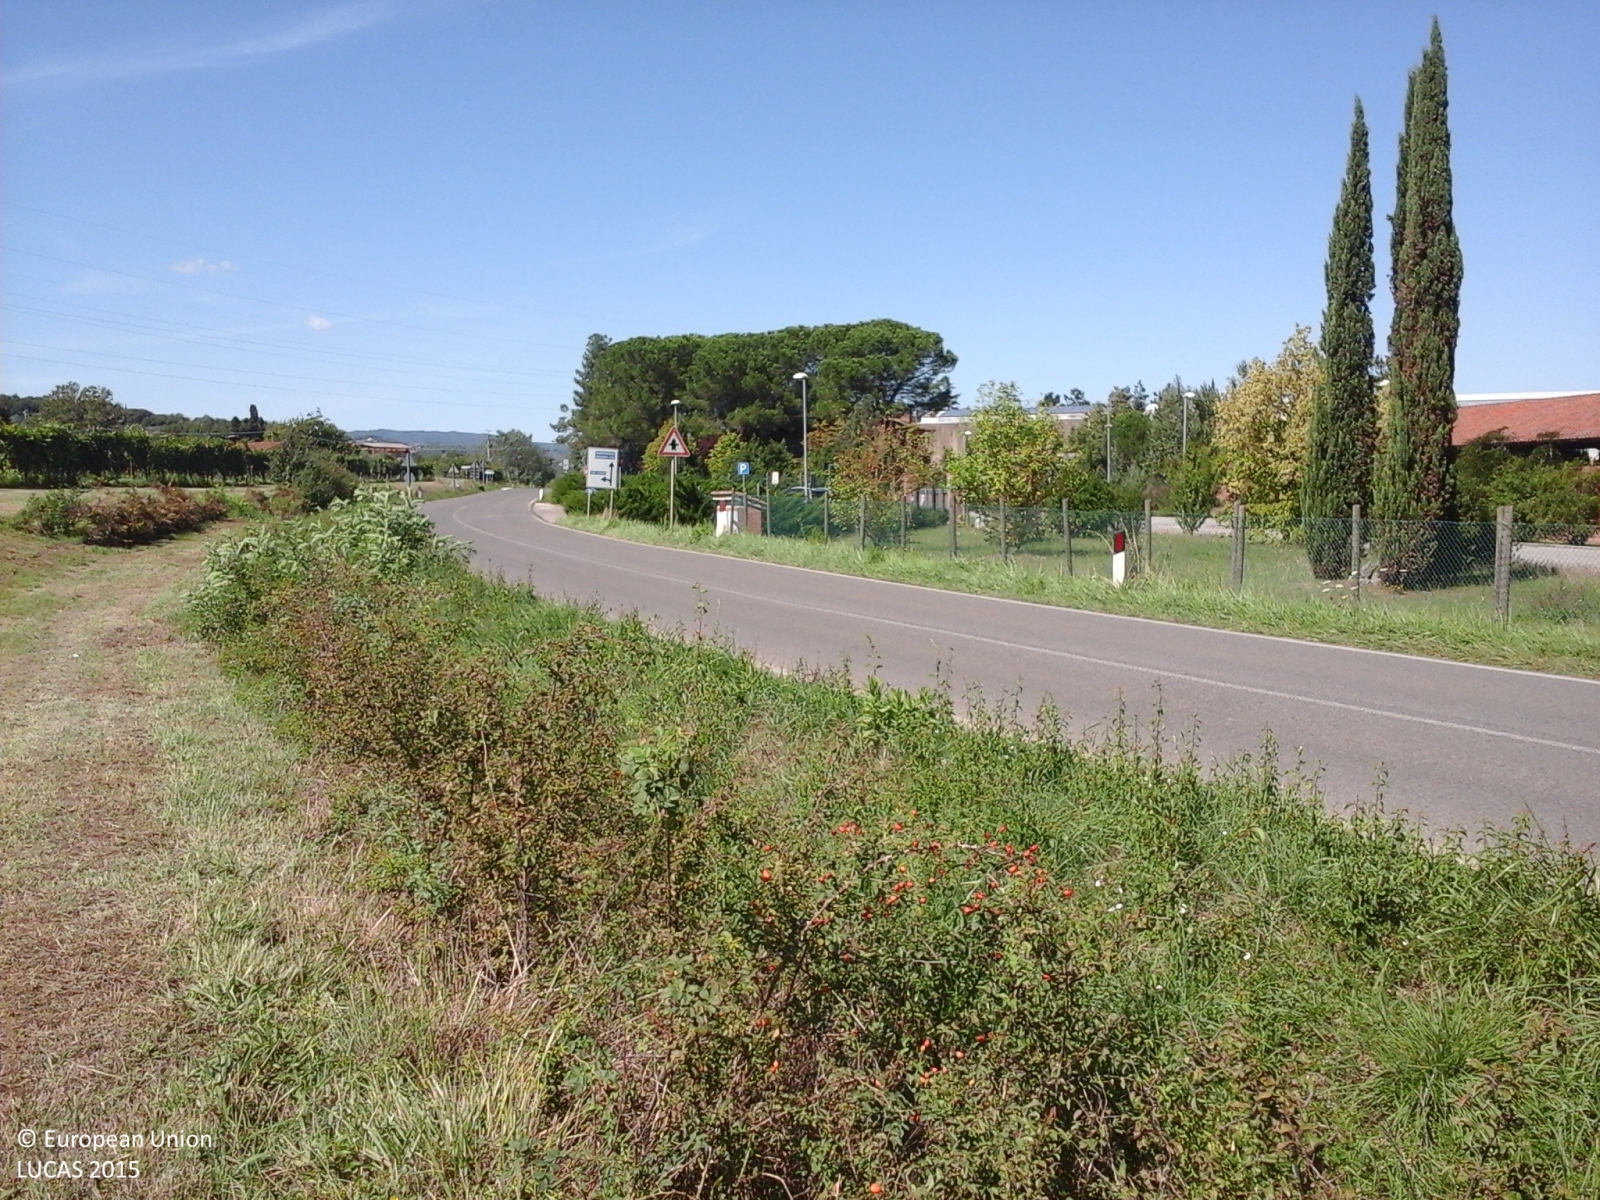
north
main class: Cropland
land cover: Vineyards
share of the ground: 25 - 50 %
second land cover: Grassland without tree/shrub cover
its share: > 75 %
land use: Agriculture (excluding fallow land and kitchen gardens)
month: September
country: IT
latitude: 43.4722
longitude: 11.5903
